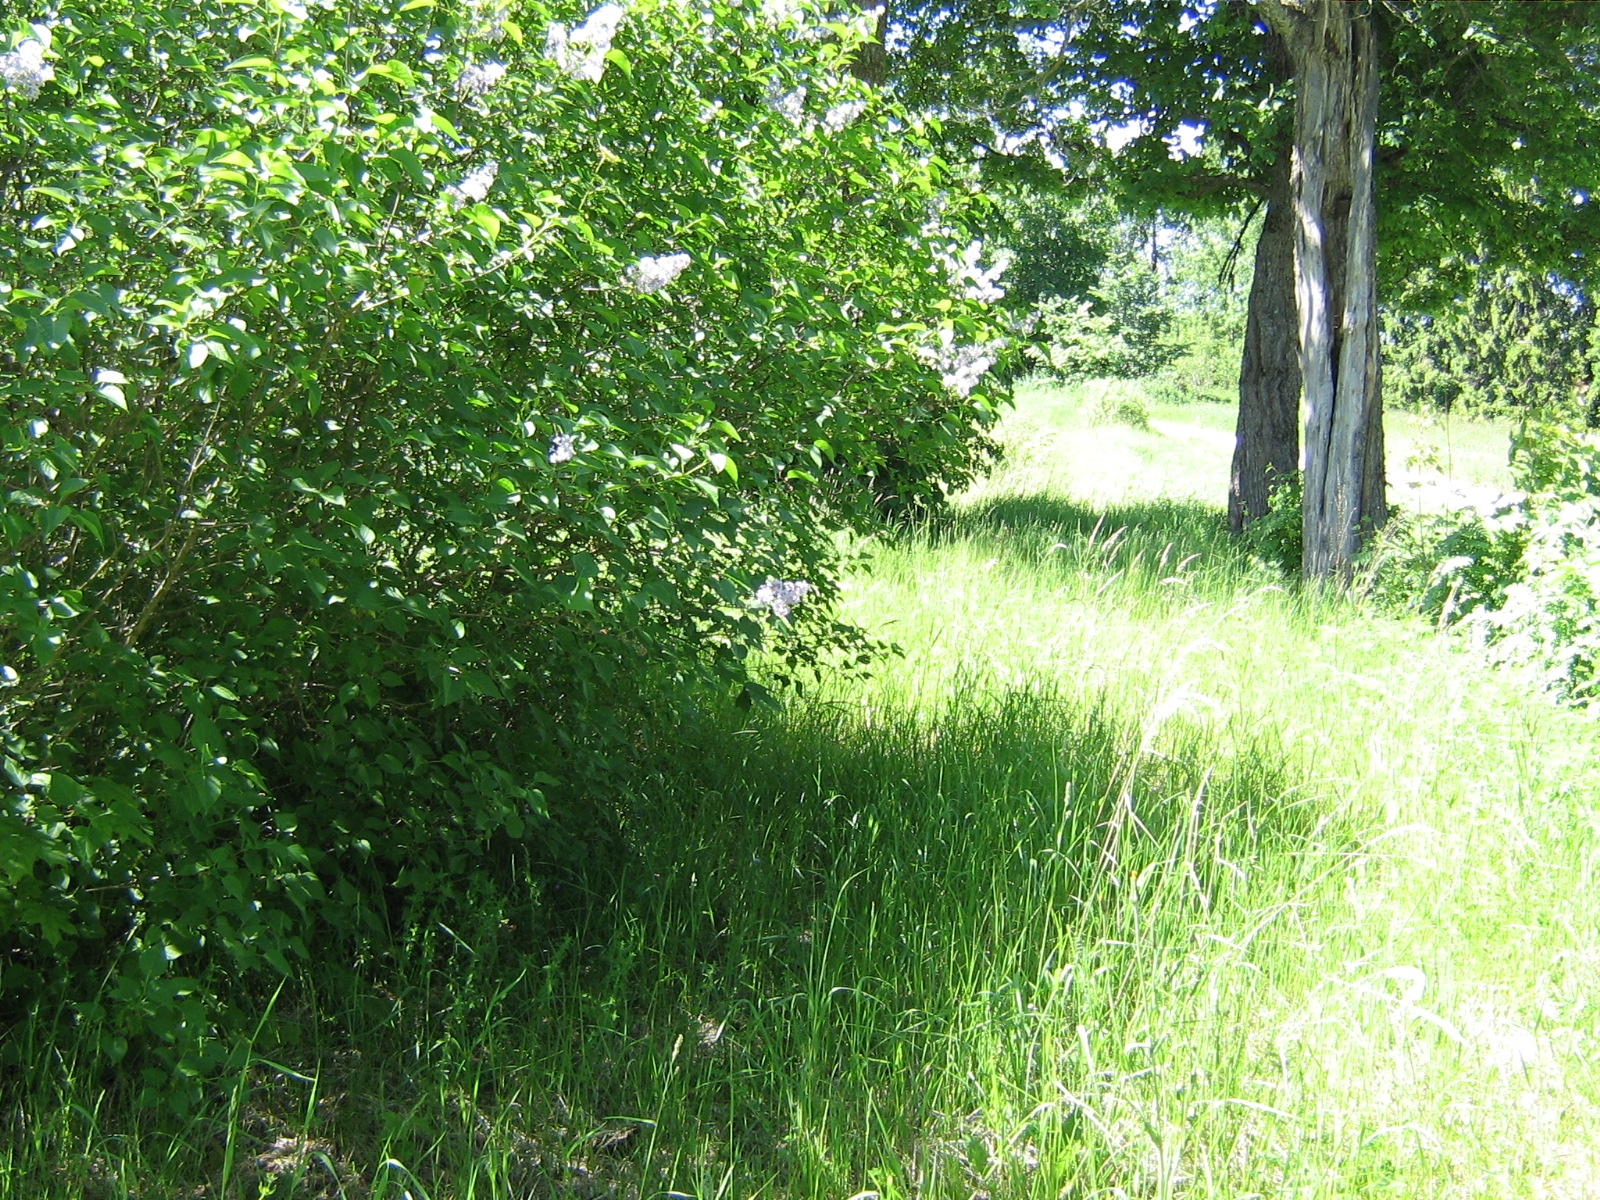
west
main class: Grassland
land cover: Spontaneously vegetated surfaces
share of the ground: > 75 %
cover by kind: herbaceous plants 95 %, shrubs 5 %
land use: Abandoned areas
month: June
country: LV
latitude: 57.1070
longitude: 25.8269
